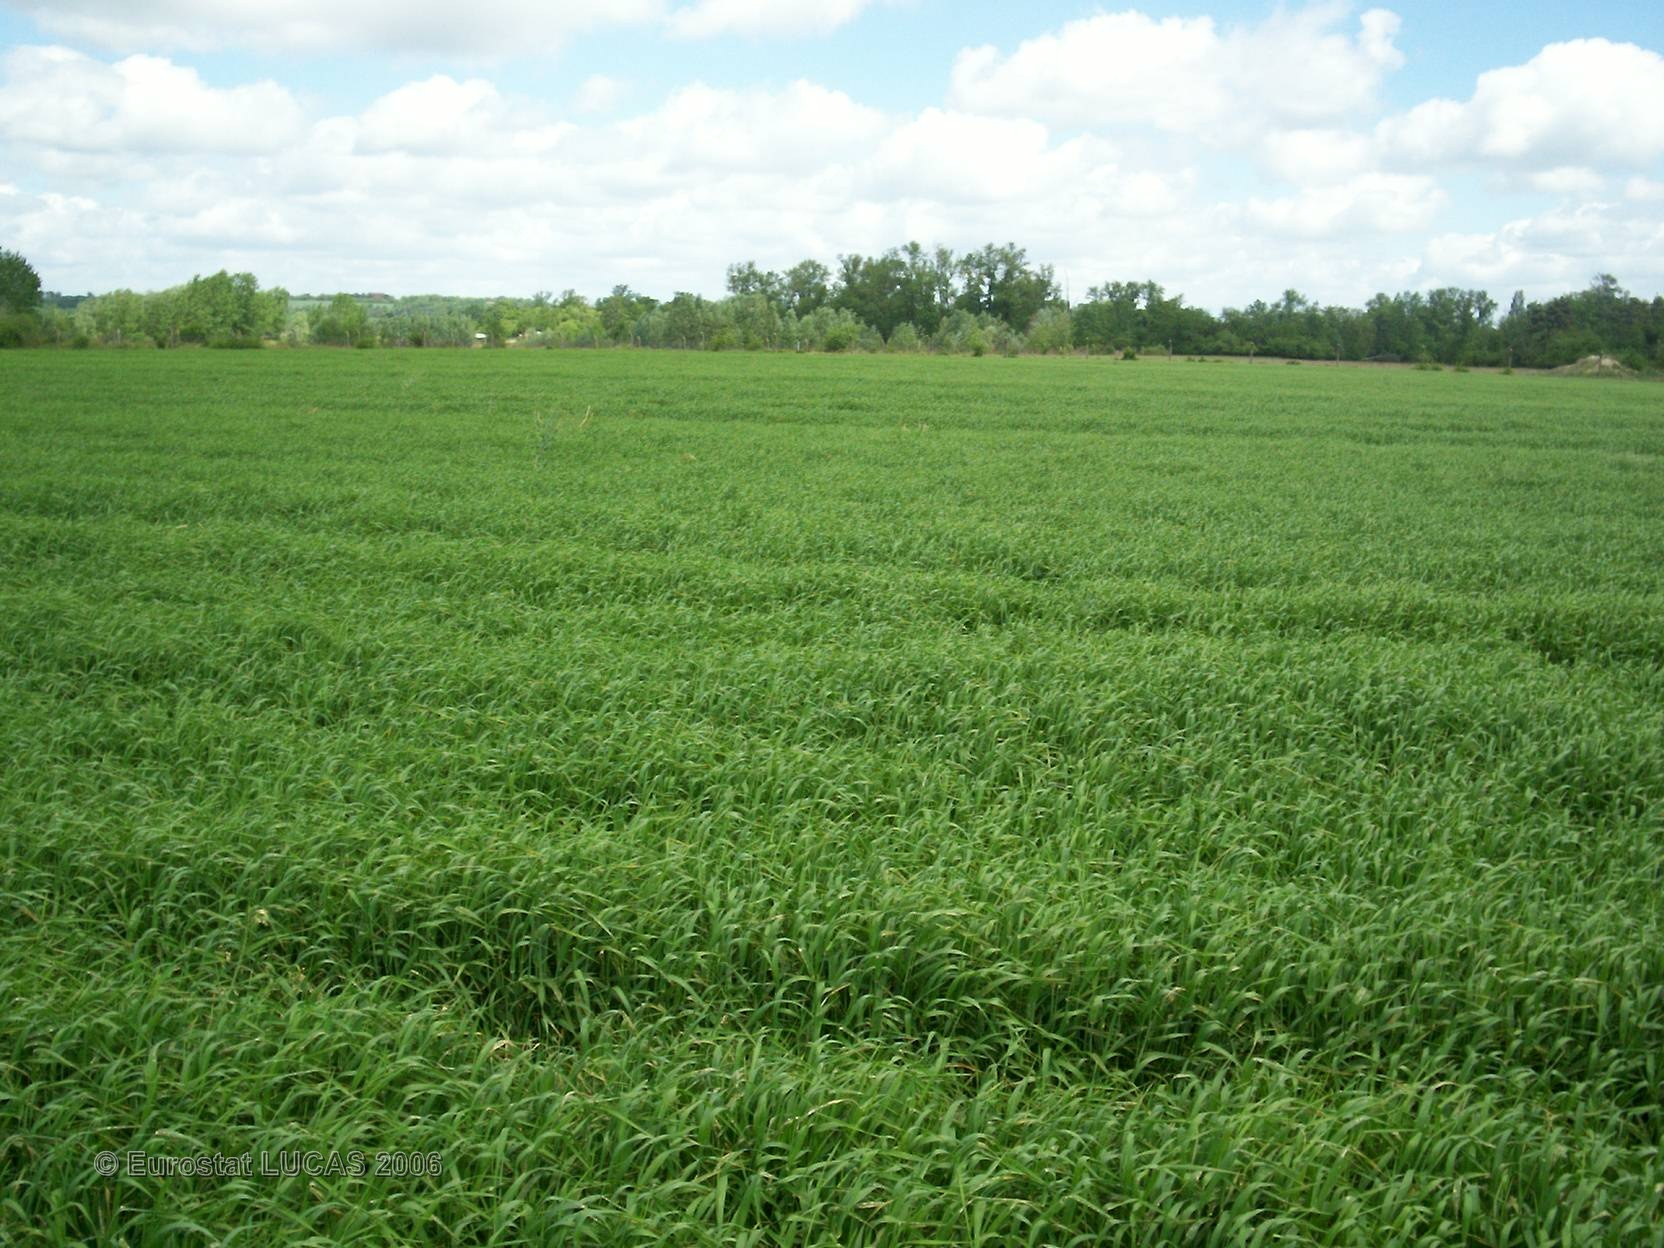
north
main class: Cropland
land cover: Barley
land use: Agriculture (excluding fallow land and kitchen gardens)
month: May
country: FR
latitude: 48.4288
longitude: 4.4968
